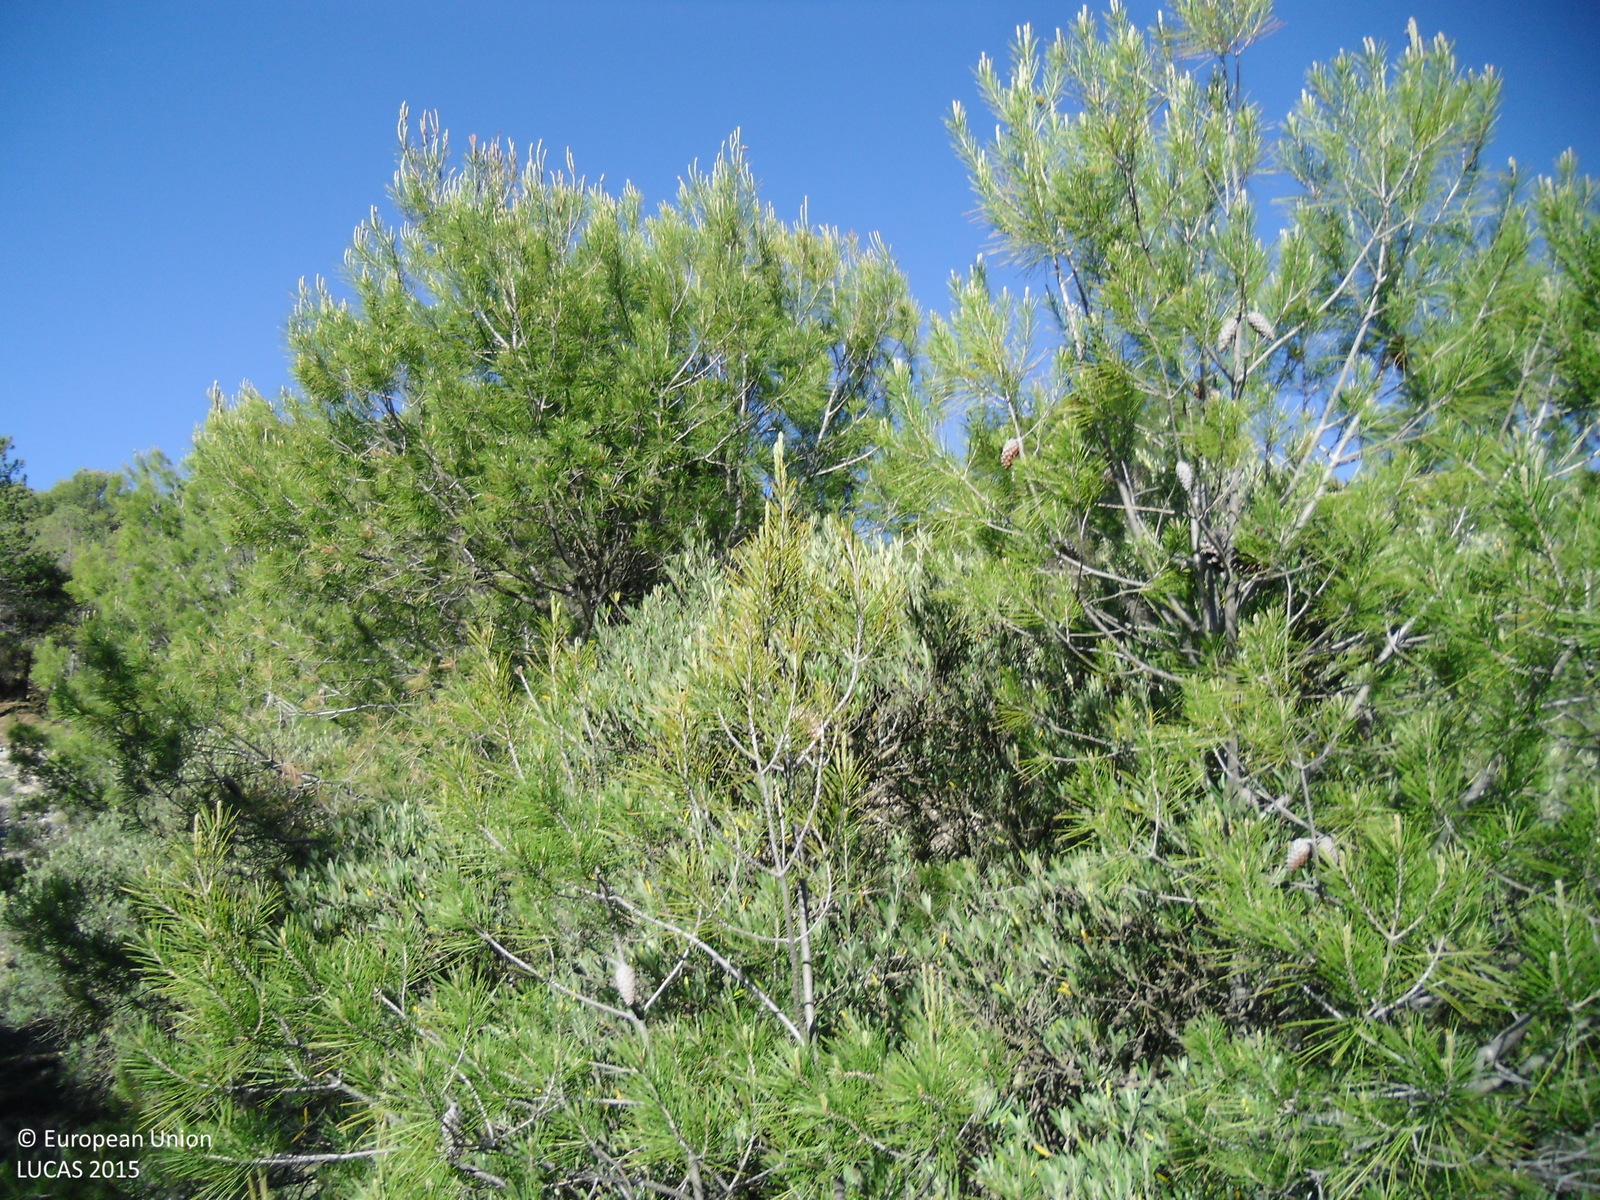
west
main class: Woodland
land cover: Pine dominated coniferous woodland
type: coniferous forest of the mediterranean region
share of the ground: 25 - 50 %
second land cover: Olive groves
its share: 50 - 75 %
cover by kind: coniferous forest trees 50 %, herbaceous plants 30 %, shrubs 20 %
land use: Forestry
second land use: Agriculture (excluding fallow land and kitchen gardens)
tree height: > 5 m
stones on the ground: 10 - 25 %
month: May
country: ES
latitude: 40.2743
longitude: -2.8799
